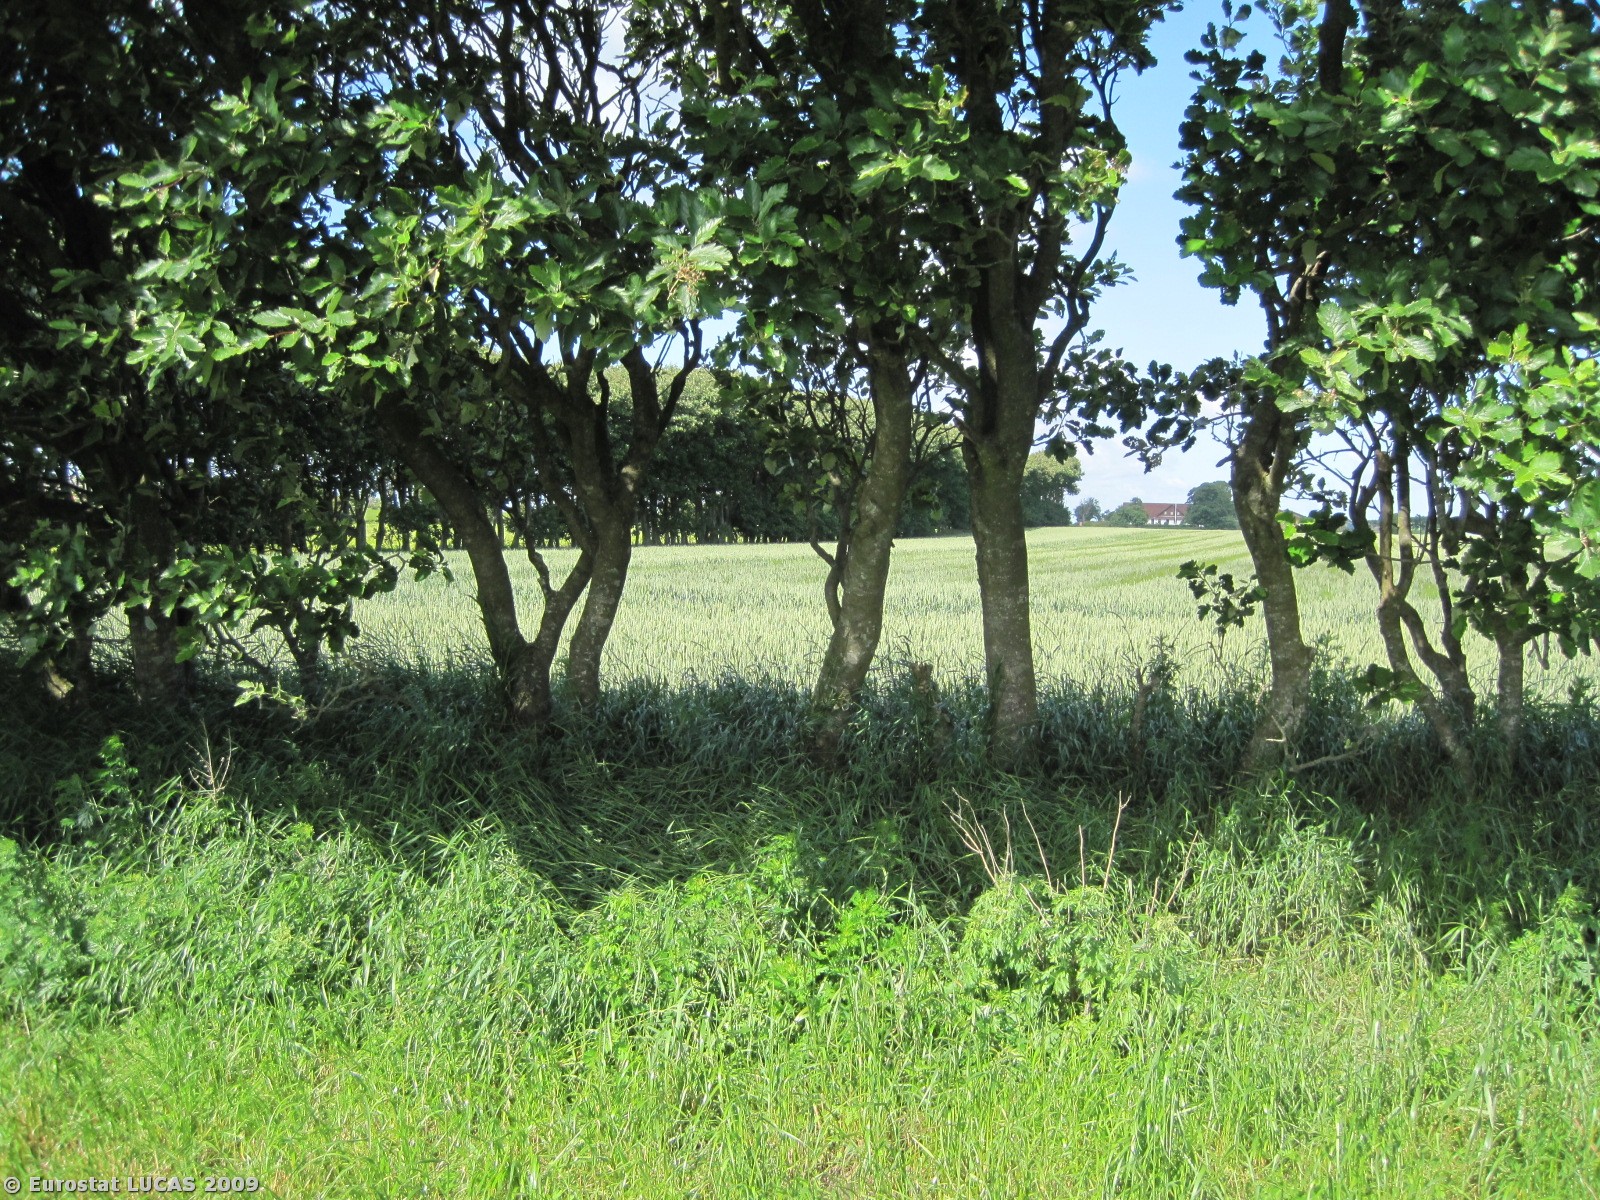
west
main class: Grassland
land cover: Grassland without tree/shrub cover
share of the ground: > 75 %
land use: Agriculture (excluding fallow land and kitchen gardens)
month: June
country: DK
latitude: 56.8866
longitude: 9.2297
